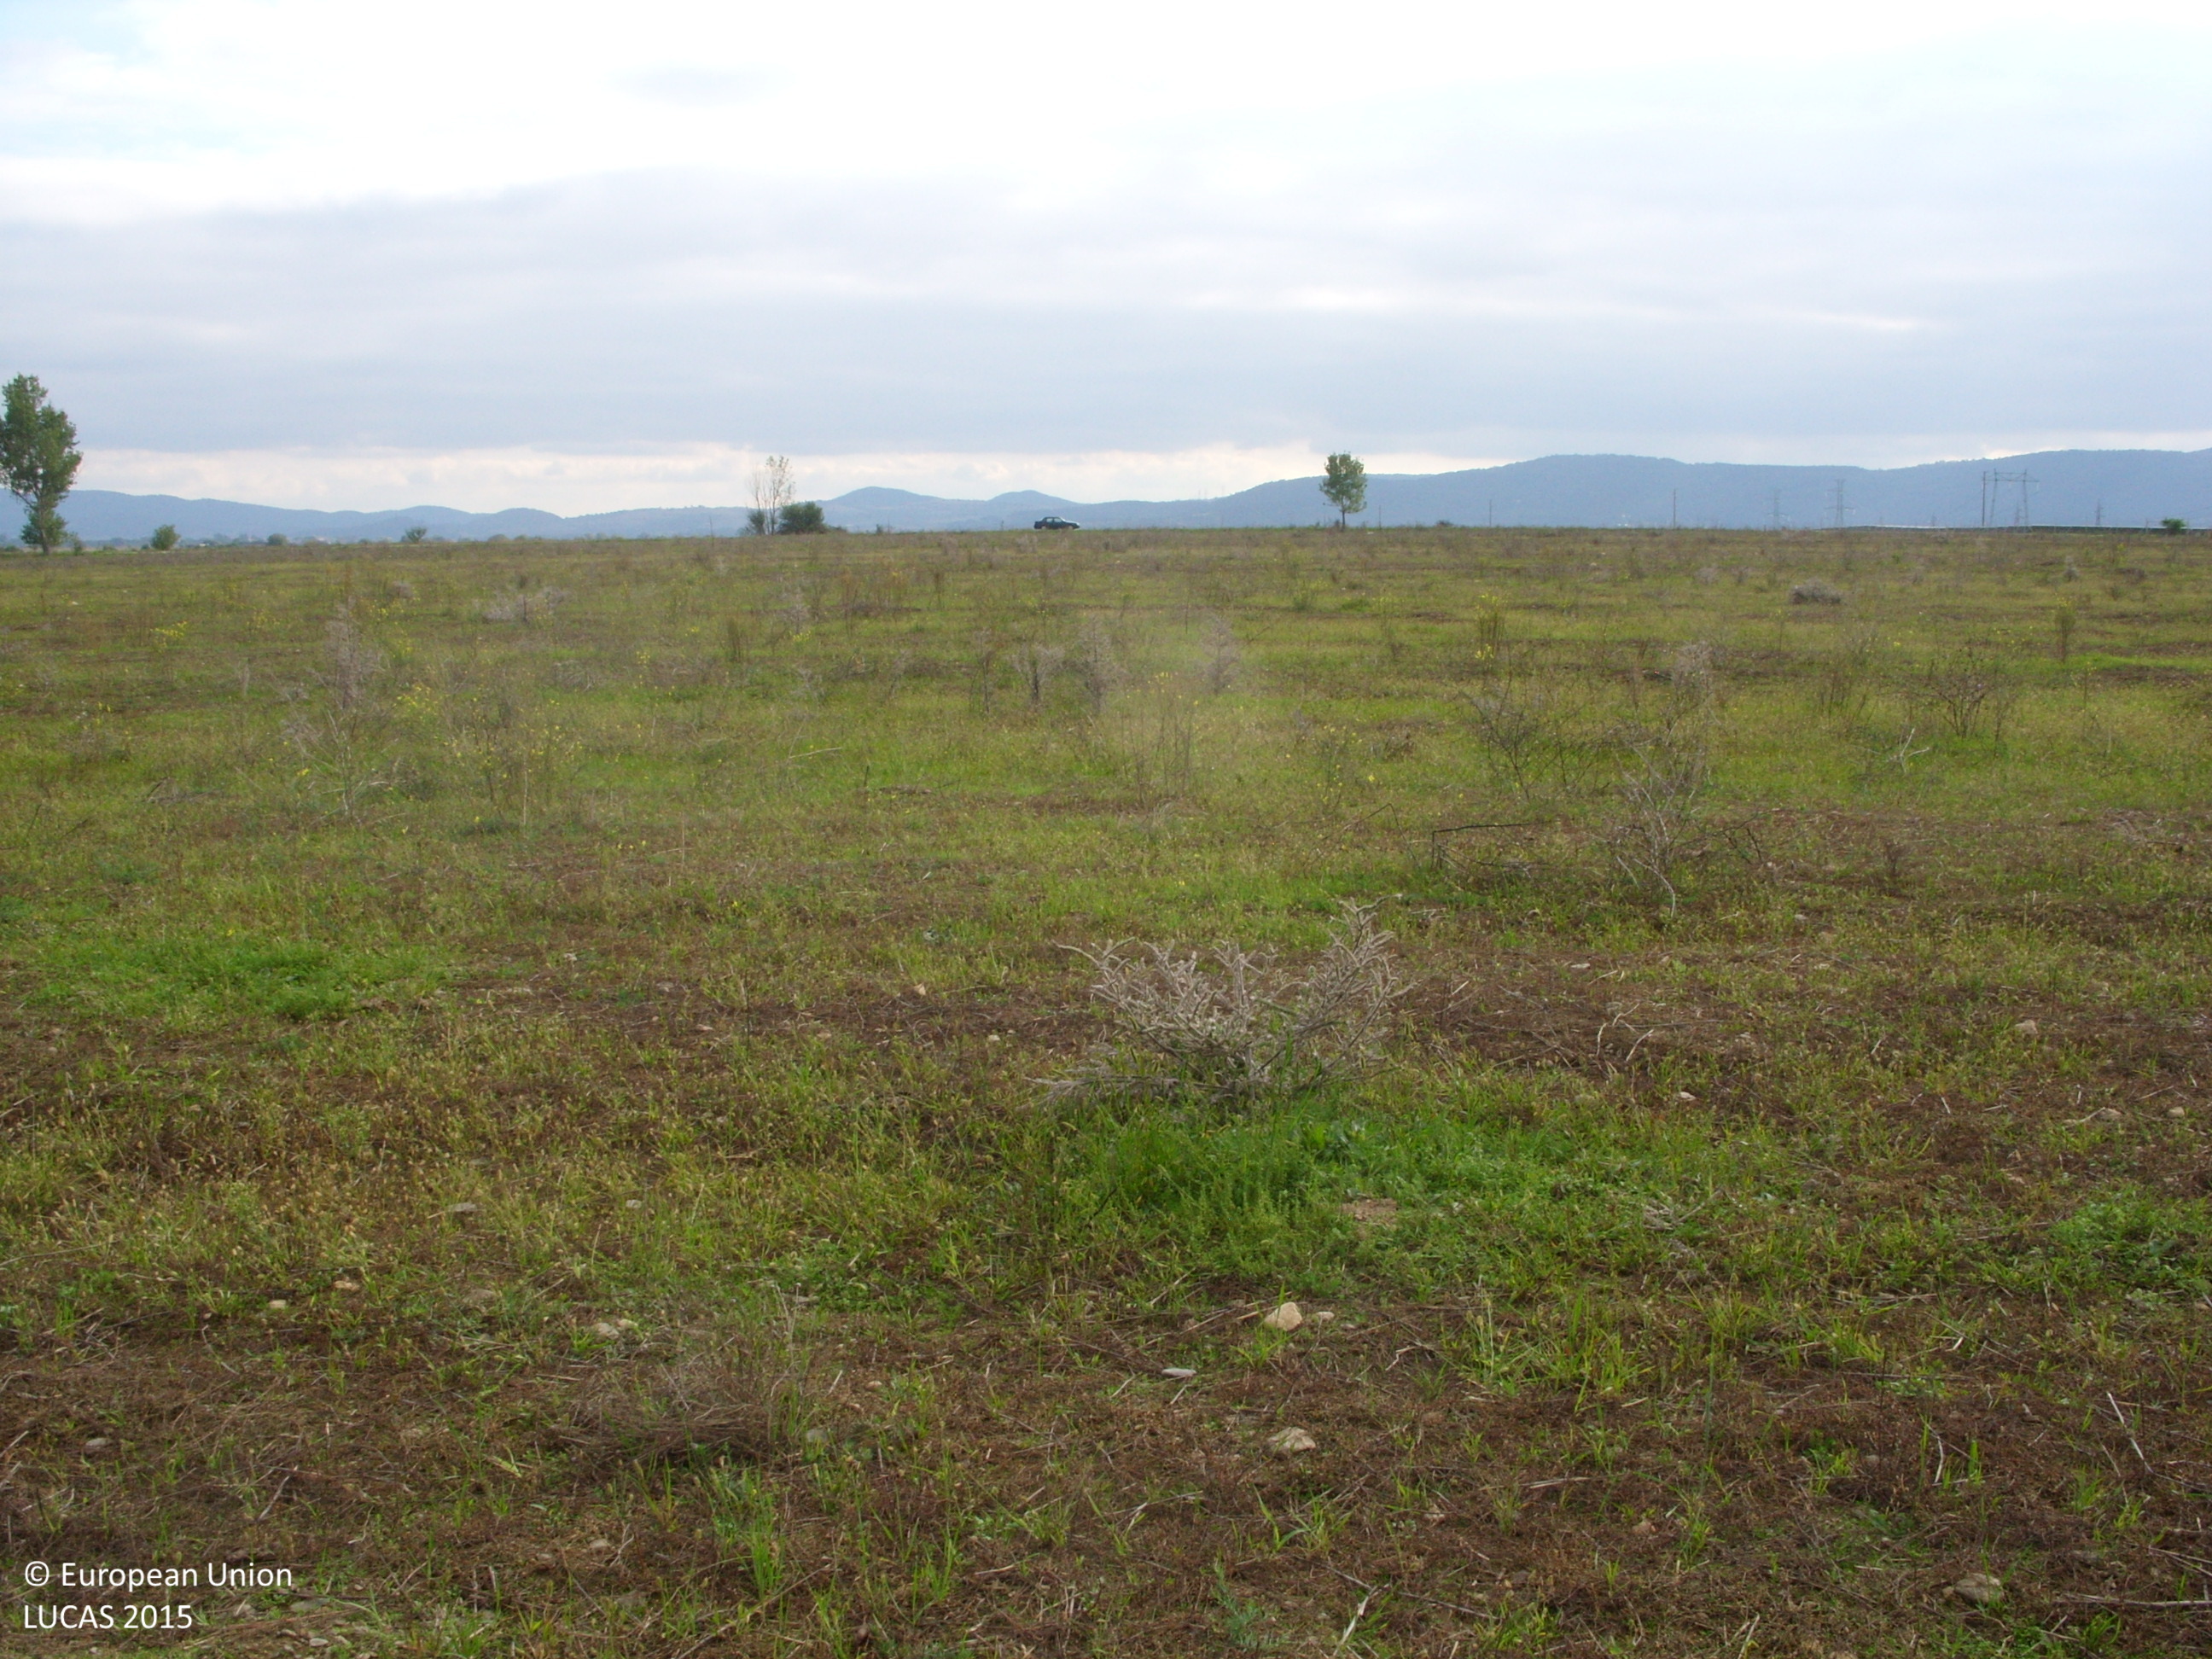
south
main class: Grassland
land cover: Spontaneously vegetated surfaces
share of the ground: > 75 %
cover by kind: herbaceous plants 90 %, unconsolidated bare surface 10 %
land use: Agriculture (excluding fallow land and kitchen gardens)
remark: Harvested field
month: October
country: BG
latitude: 42.5842
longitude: 24.8136
